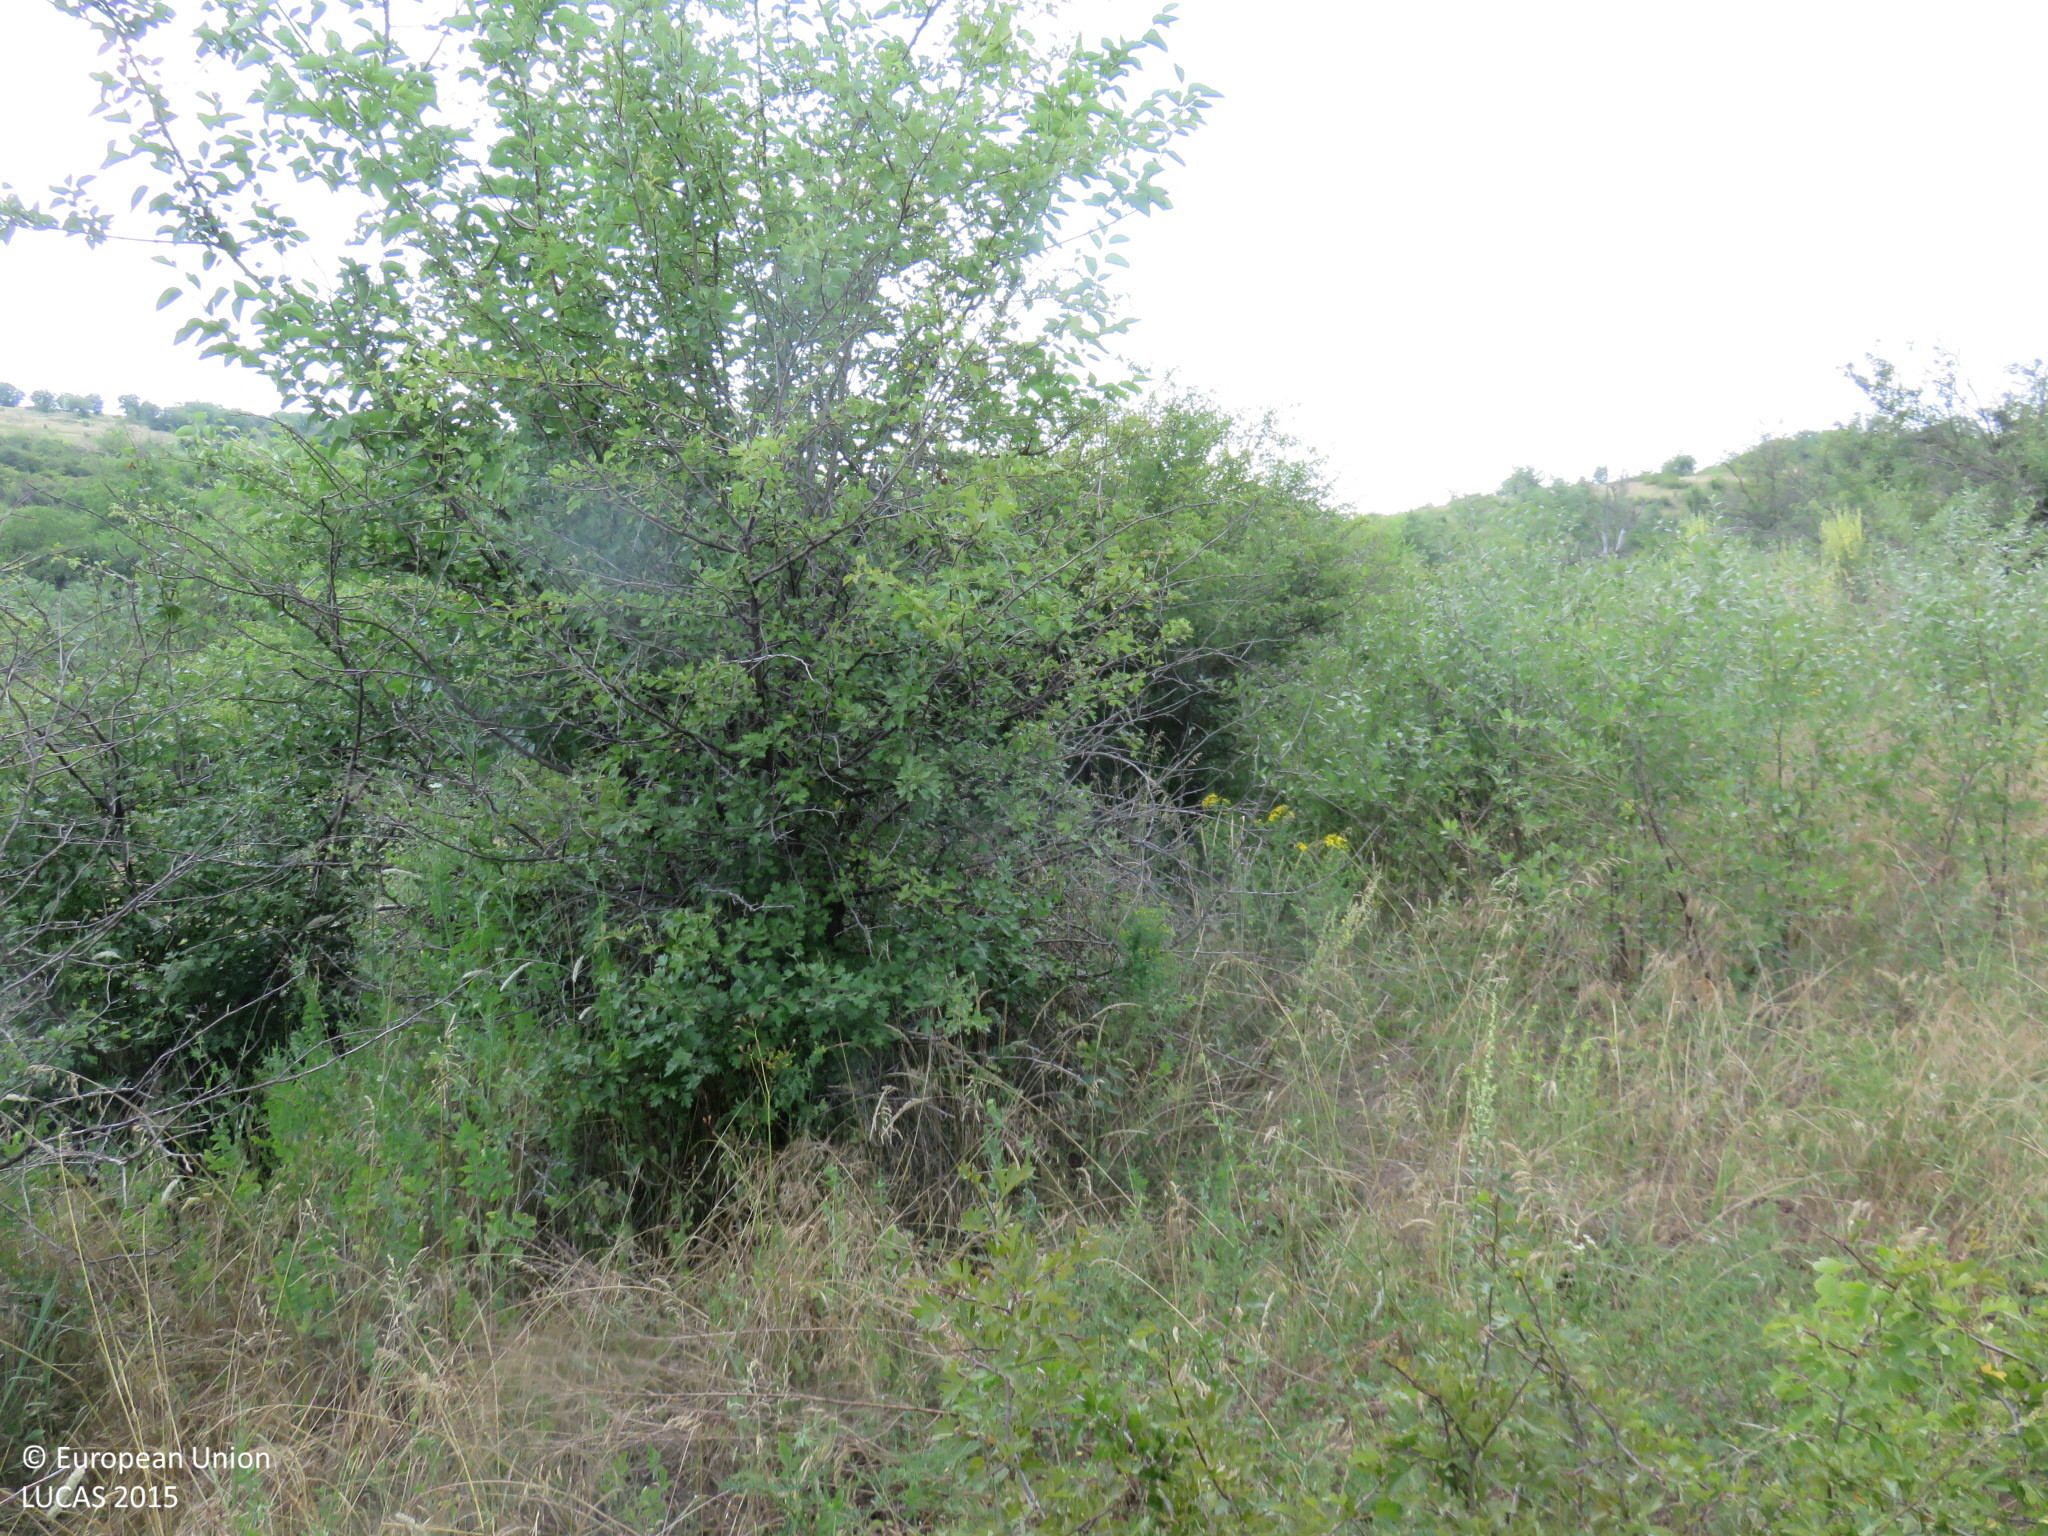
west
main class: Cropland
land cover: Other fruit trees and berries
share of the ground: 25 - 50 %
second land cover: Spontaneously vegetated surfaces
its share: > 75 %
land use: Abandoned areas
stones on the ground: < 10 %
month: June
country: BG
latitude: 43.6679
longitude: 24.4106
